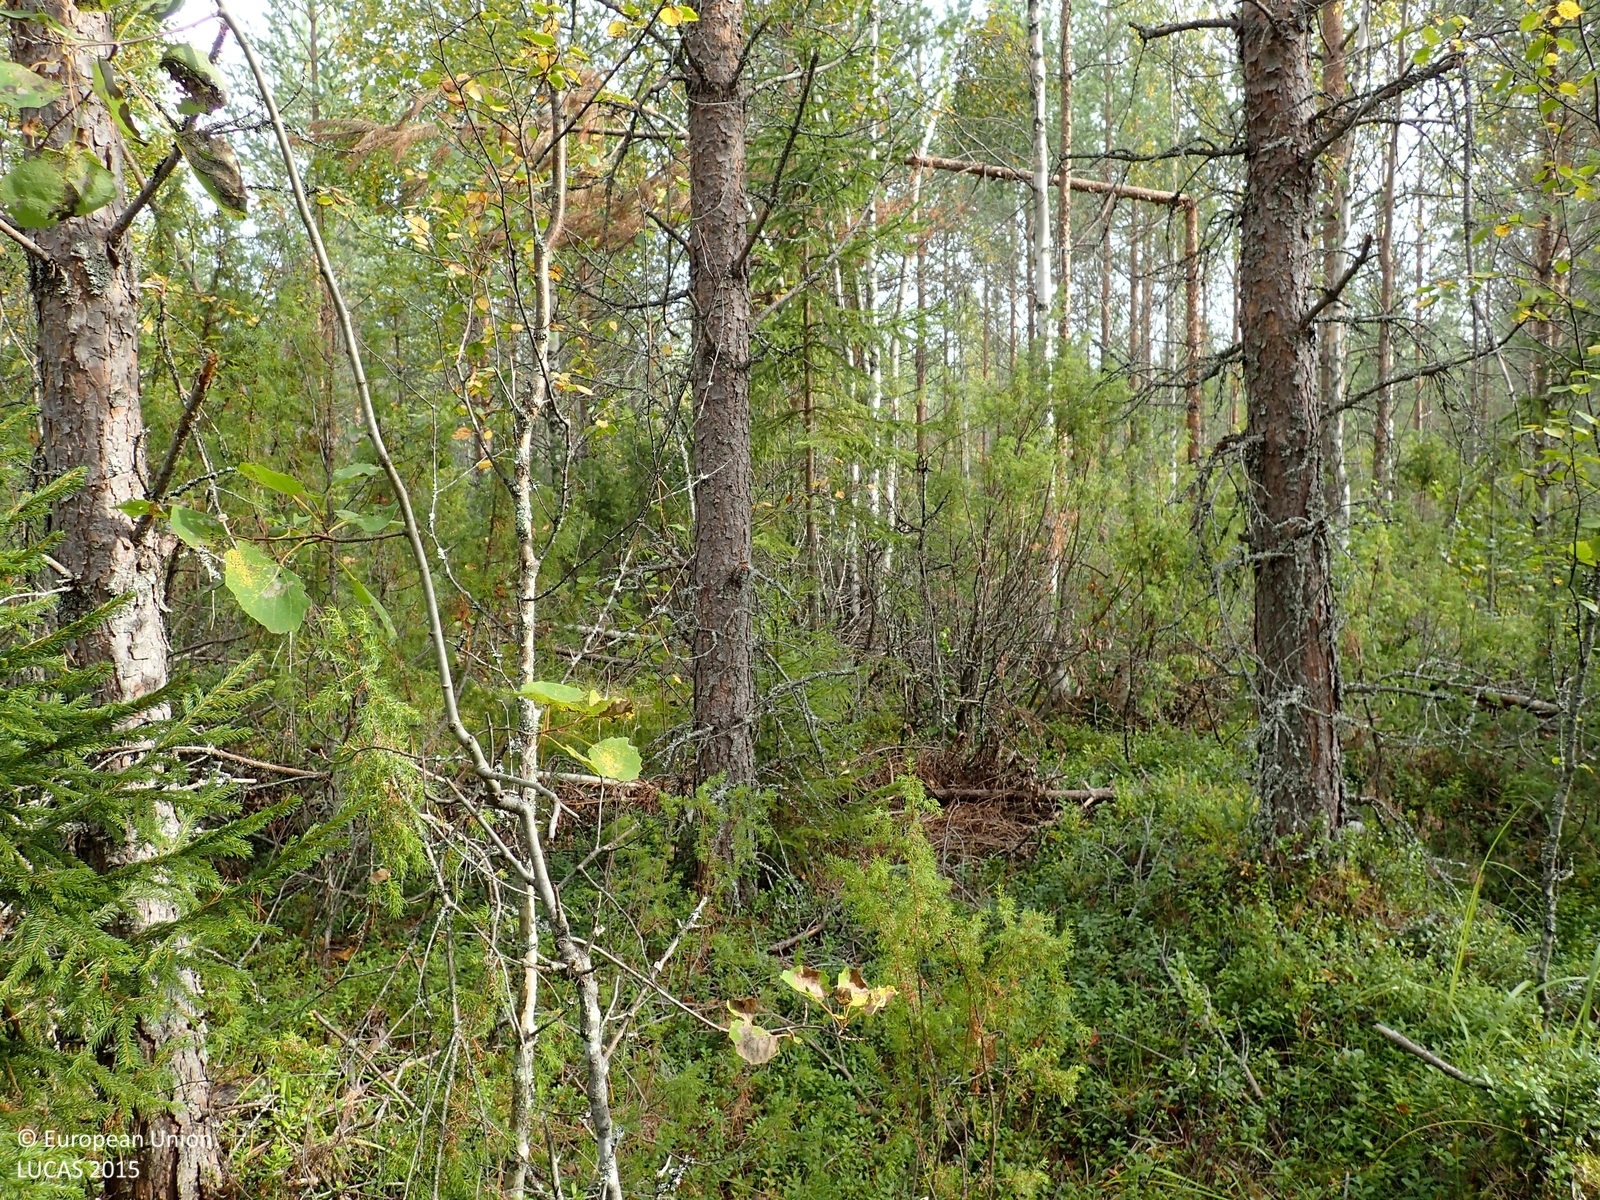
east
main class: Woodland
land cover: Pine dominated mixed woodland
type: boreal forest
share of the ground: > 75 %
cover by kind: coniferous forest trees 55 %, shrubs 25 %, broadleaved forest trees 20 %
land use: Forestry
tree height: > 5 m
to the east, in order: Pine dominated mixed woodland; Ditches and canals; Pine dominated mixed woodland; Tracks; Pine dominated coniferous woodland; Ditches and canals; Pine dominated mixed woodland
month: September
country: FI
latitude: 63.0824
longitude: 26.1395
